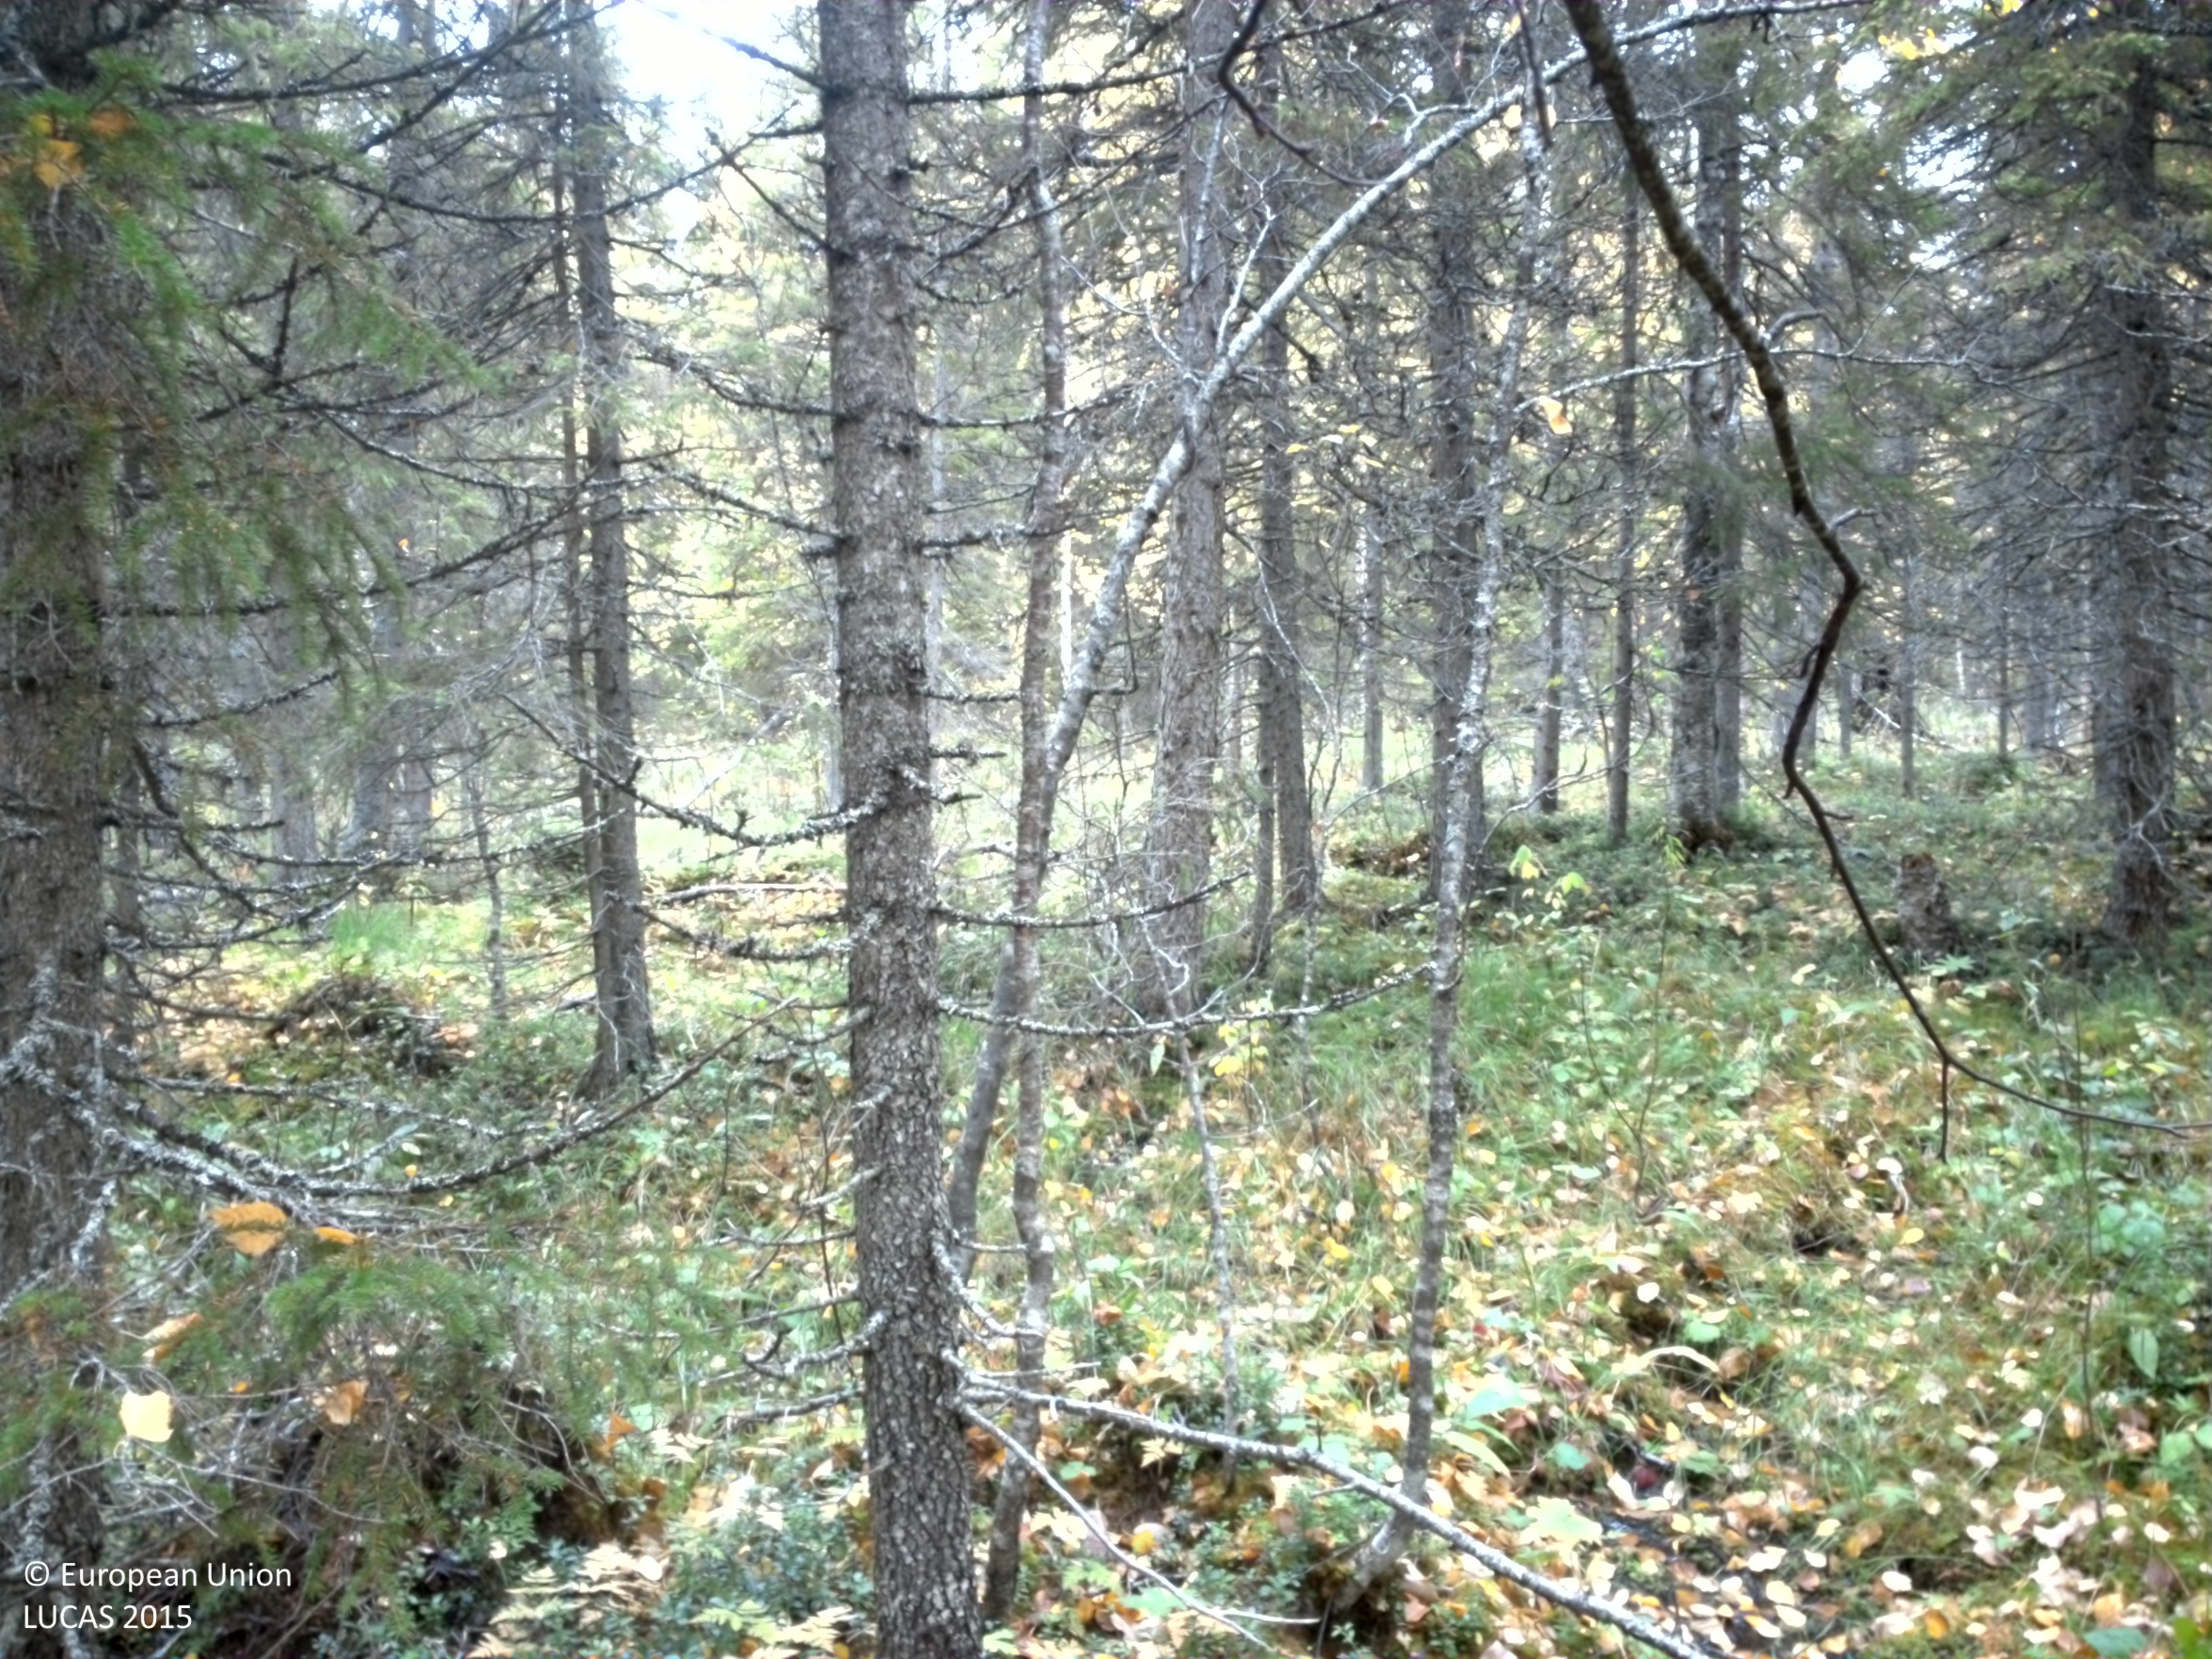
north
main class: Woodland
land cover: Spruce dominated mixed woodland
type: boreal forest
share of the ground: 50 - 75 %
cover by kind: coniferous forest trees 35 %, broadleaved forest trees 25 %, herbaceous plants 20 %, shrubs 10 %, lichens and mosses 10 %
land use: Forestry
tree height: > 5 m
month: September
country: SE
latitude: 65.3639
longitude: 16.2194
